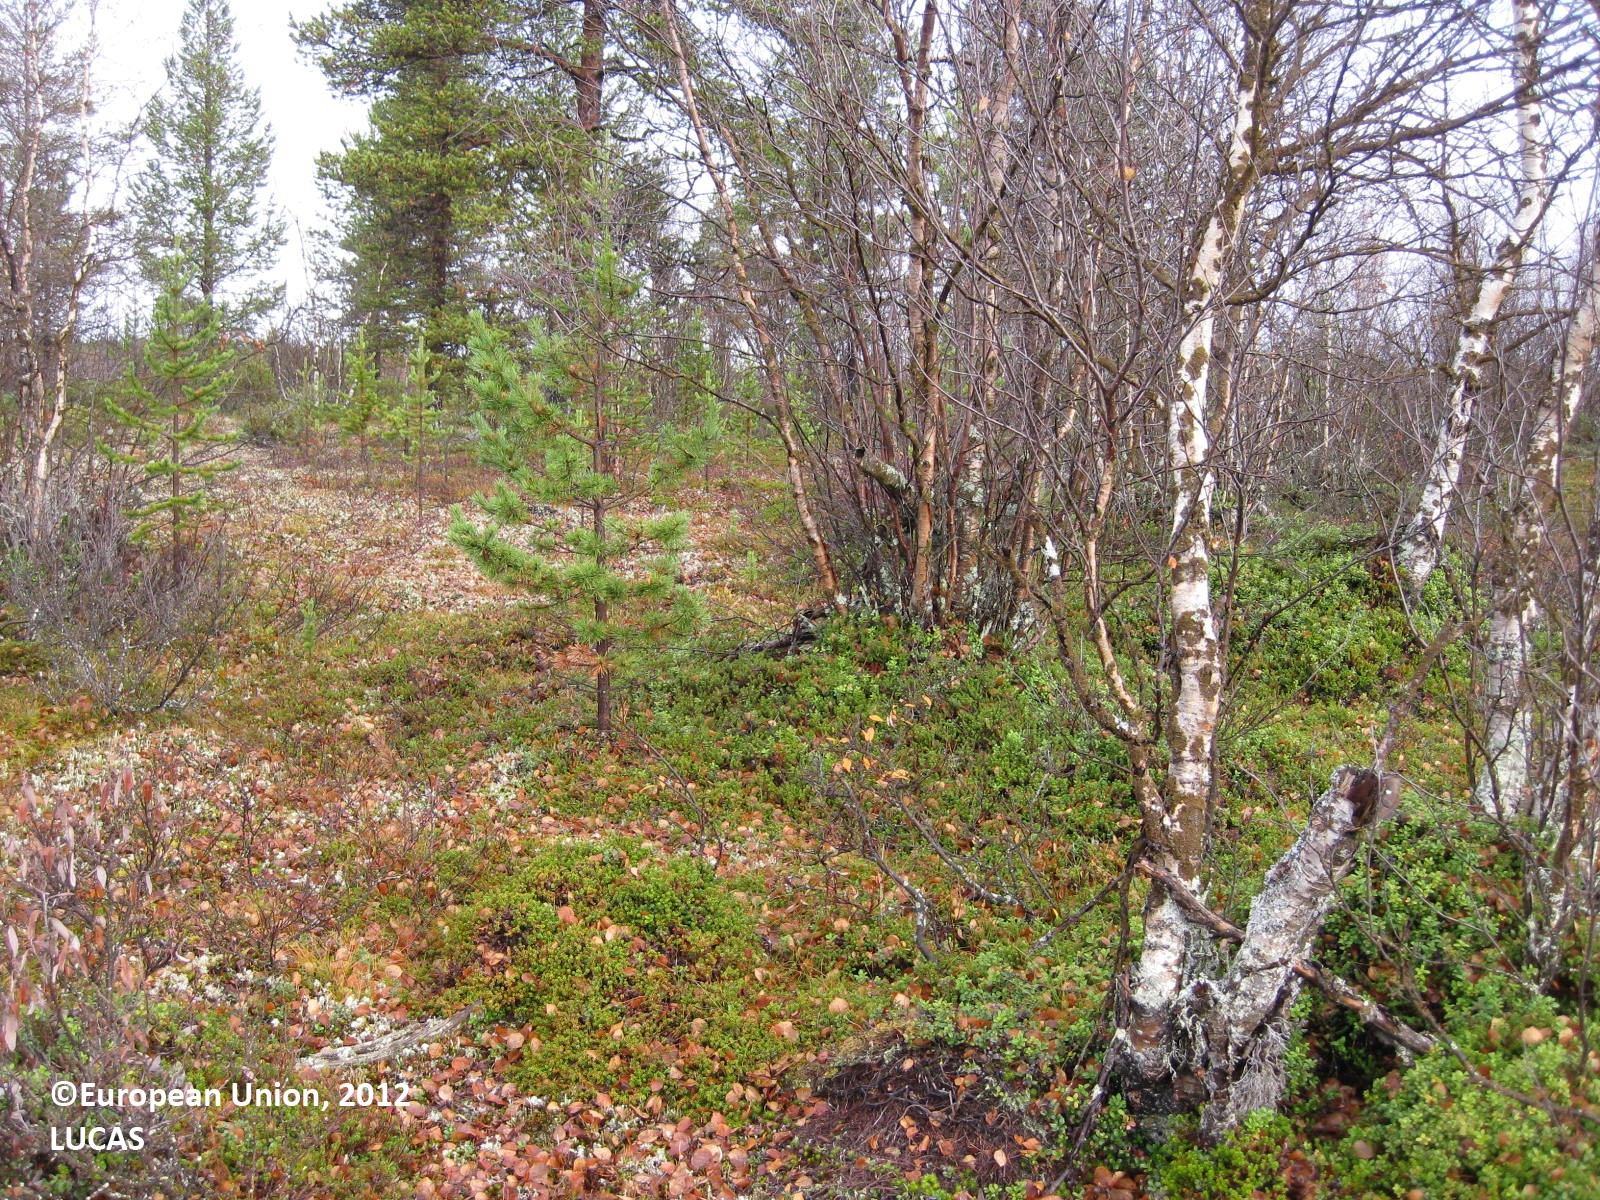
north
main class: Woodland
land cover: Pine dominated mixed woodland
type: boreal forest
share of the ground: 50 - 75 %
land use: Semi-natural and natural areas not in use
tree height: > 5 m
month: September
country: FI
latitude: 68.3999
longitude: 24.3028
